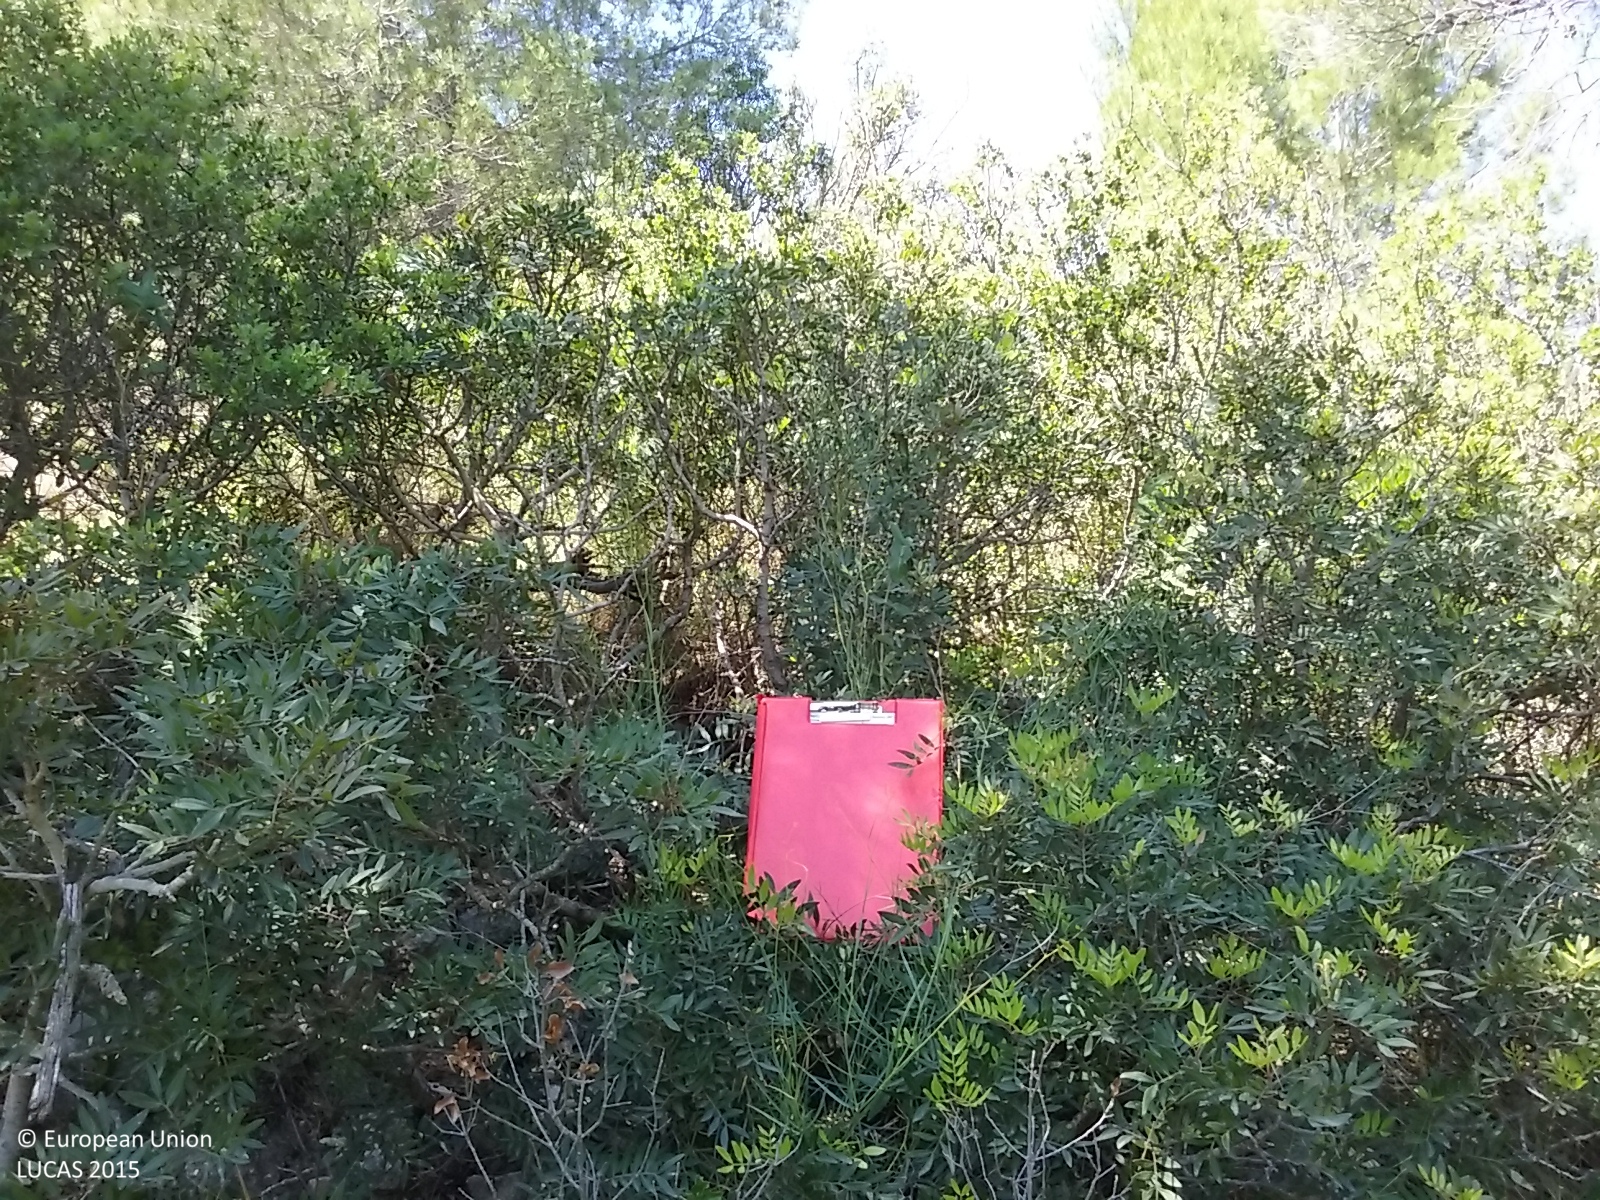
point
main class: Woodland
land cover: Pine dominated coniferous woodland
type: coniferous forest of the mediterranean region
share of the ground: > 75 %
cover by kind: coniferous forest trees 80 %, shrubs 20 %
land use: Semi-natural and natural areas not in use
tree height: > 5 m
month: June
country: ES
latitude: 41.2053
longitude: 0.4857
